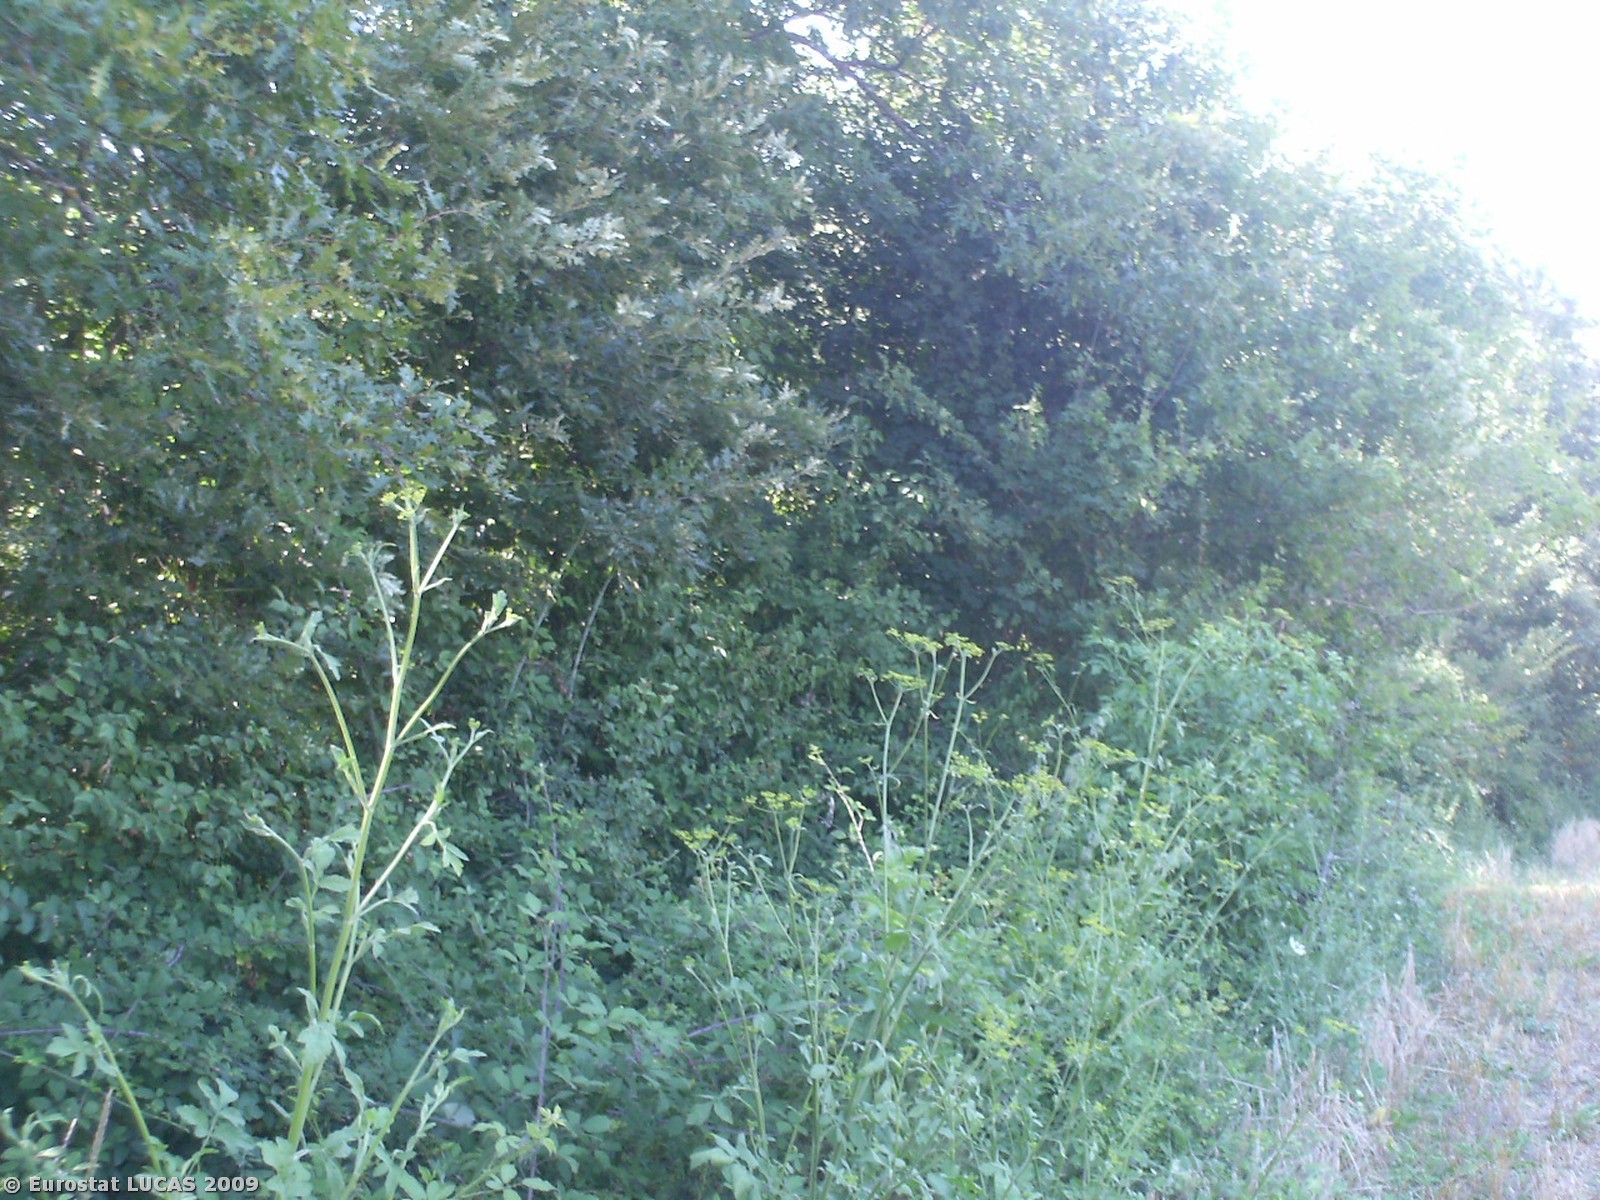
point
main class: Woodland
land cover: Mixed woodland
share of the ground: > 75 %
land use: Unused
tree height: > 5 m
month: July
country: IT
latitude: 43.6007
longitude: 12.4095
